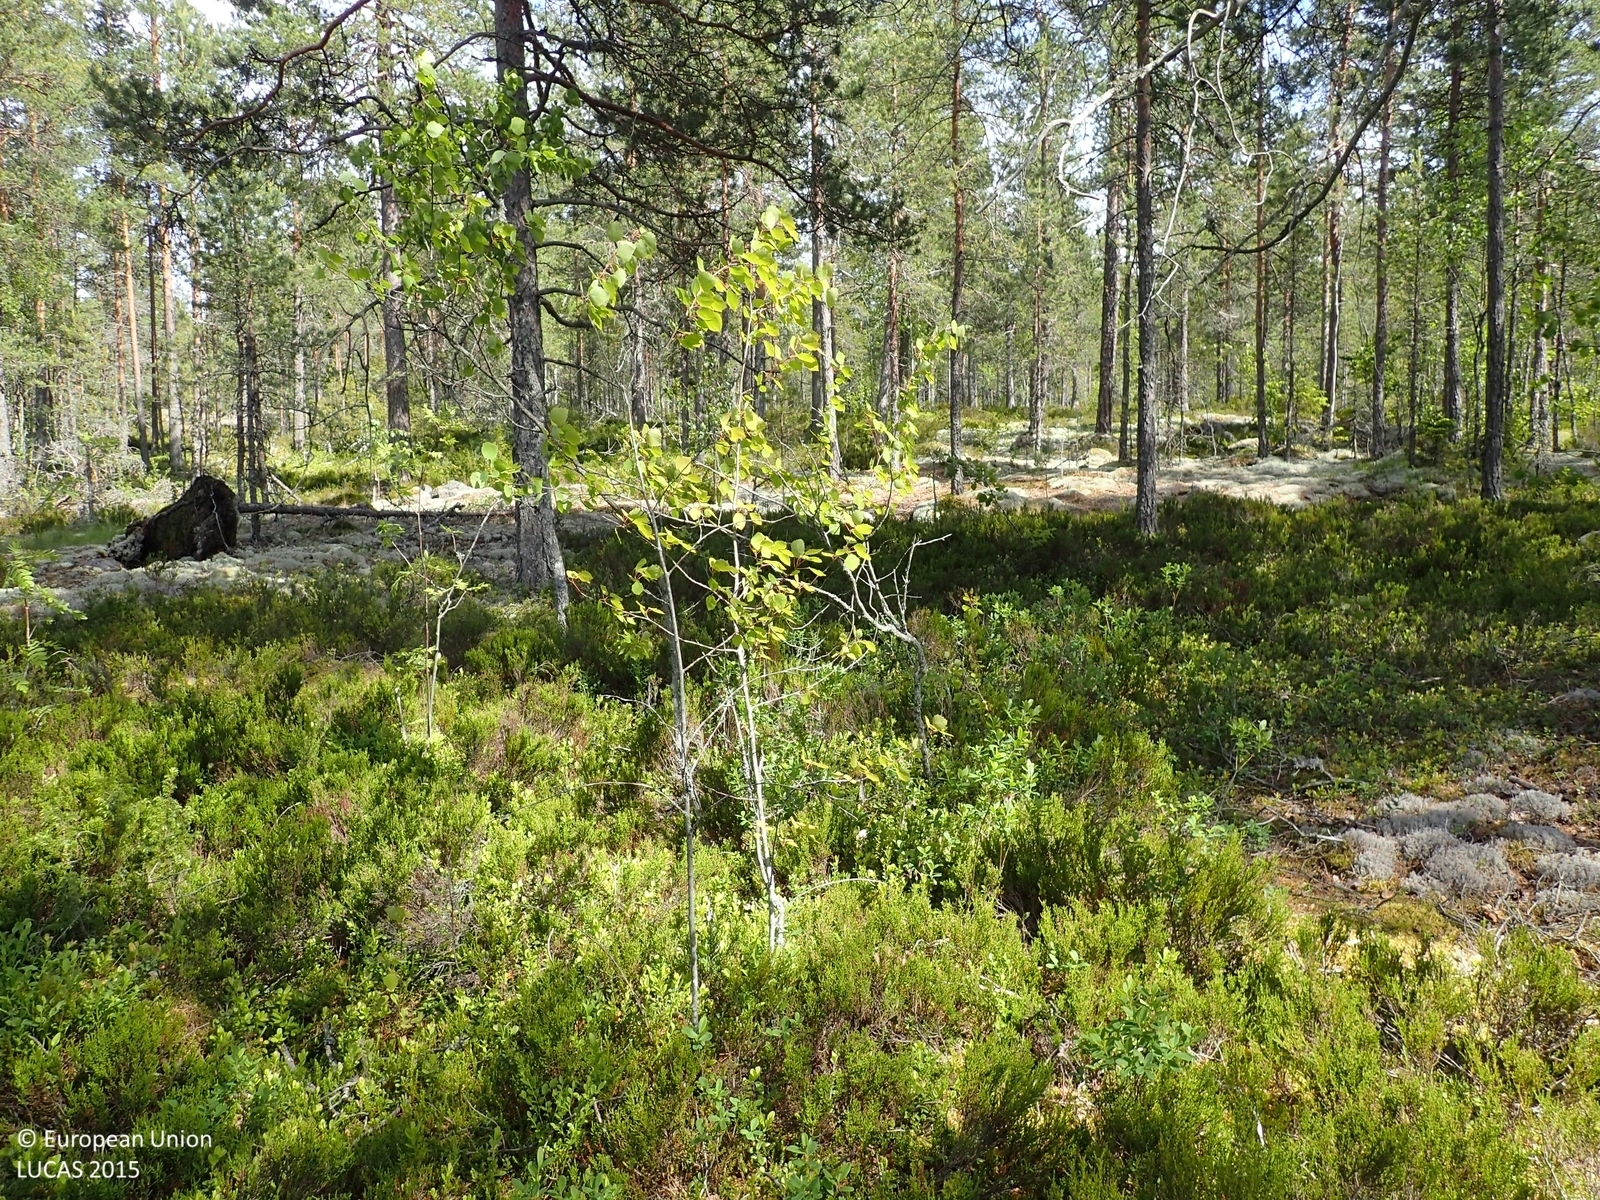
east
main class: Woodland
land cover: Pine dominated coniferous woodland
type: boreal forest
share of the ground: 25 - 50 %
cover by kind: shrubs 50 %, coniferous forest trees 40 %, broadleaved forest trees 5 %, lichens and mosses 5 %
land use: Forestry
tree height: > 5 m
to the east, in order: Pine dominated coniferous woodland; Tracks; Pine dominated coniferous woodland; Pine dominated mixed woodland; Broadleaved woodland; Tracks; Broadleaved woodland; Pine dominated mixed woodland; Ditches and canals; Grass margins; Paved roads, cycling and walking lanes; Grass margins; Ditches and canals; Pine dominated mixed woodland
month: June
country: FI
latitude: 62.4327
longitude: 21.6475
